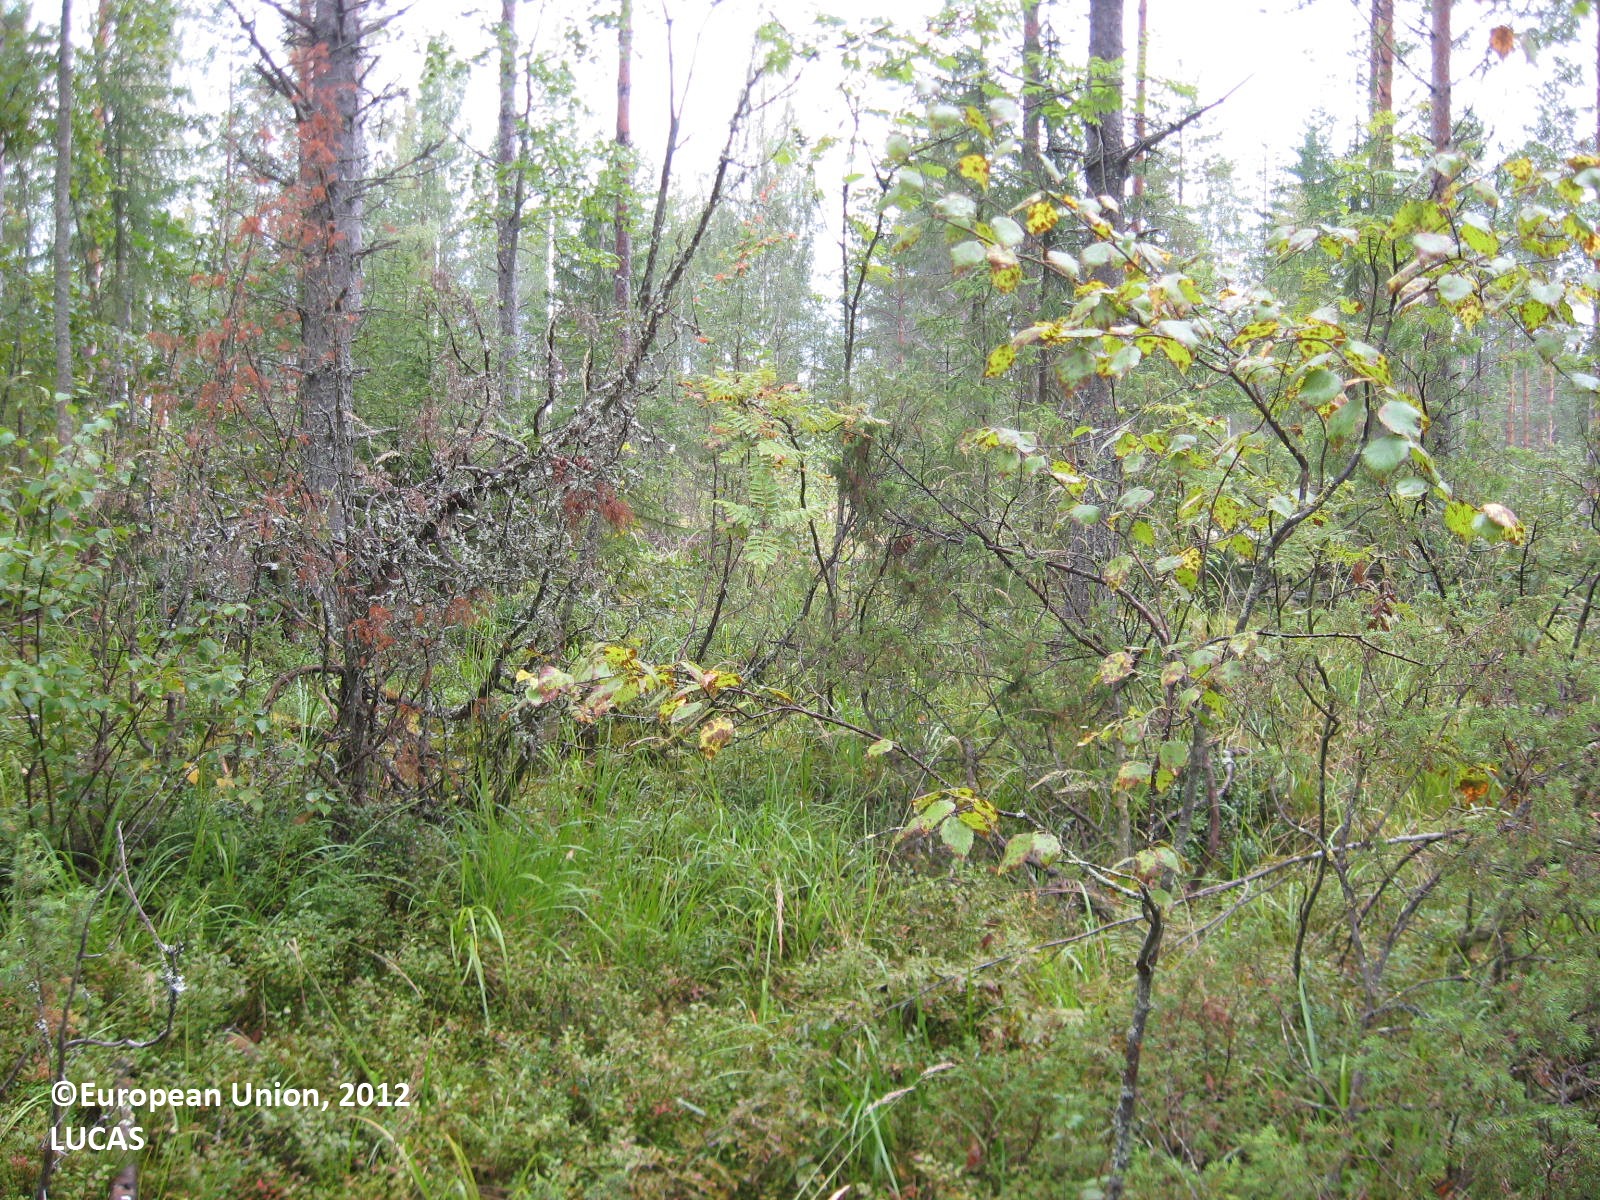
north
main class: Woodland
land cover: Pine dominated coniferous woodland
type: boreal forest
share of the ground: > 75 %
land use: Forestry
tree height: > 5 m
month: August
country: FI
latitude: 63.4999
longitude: 29.8261
